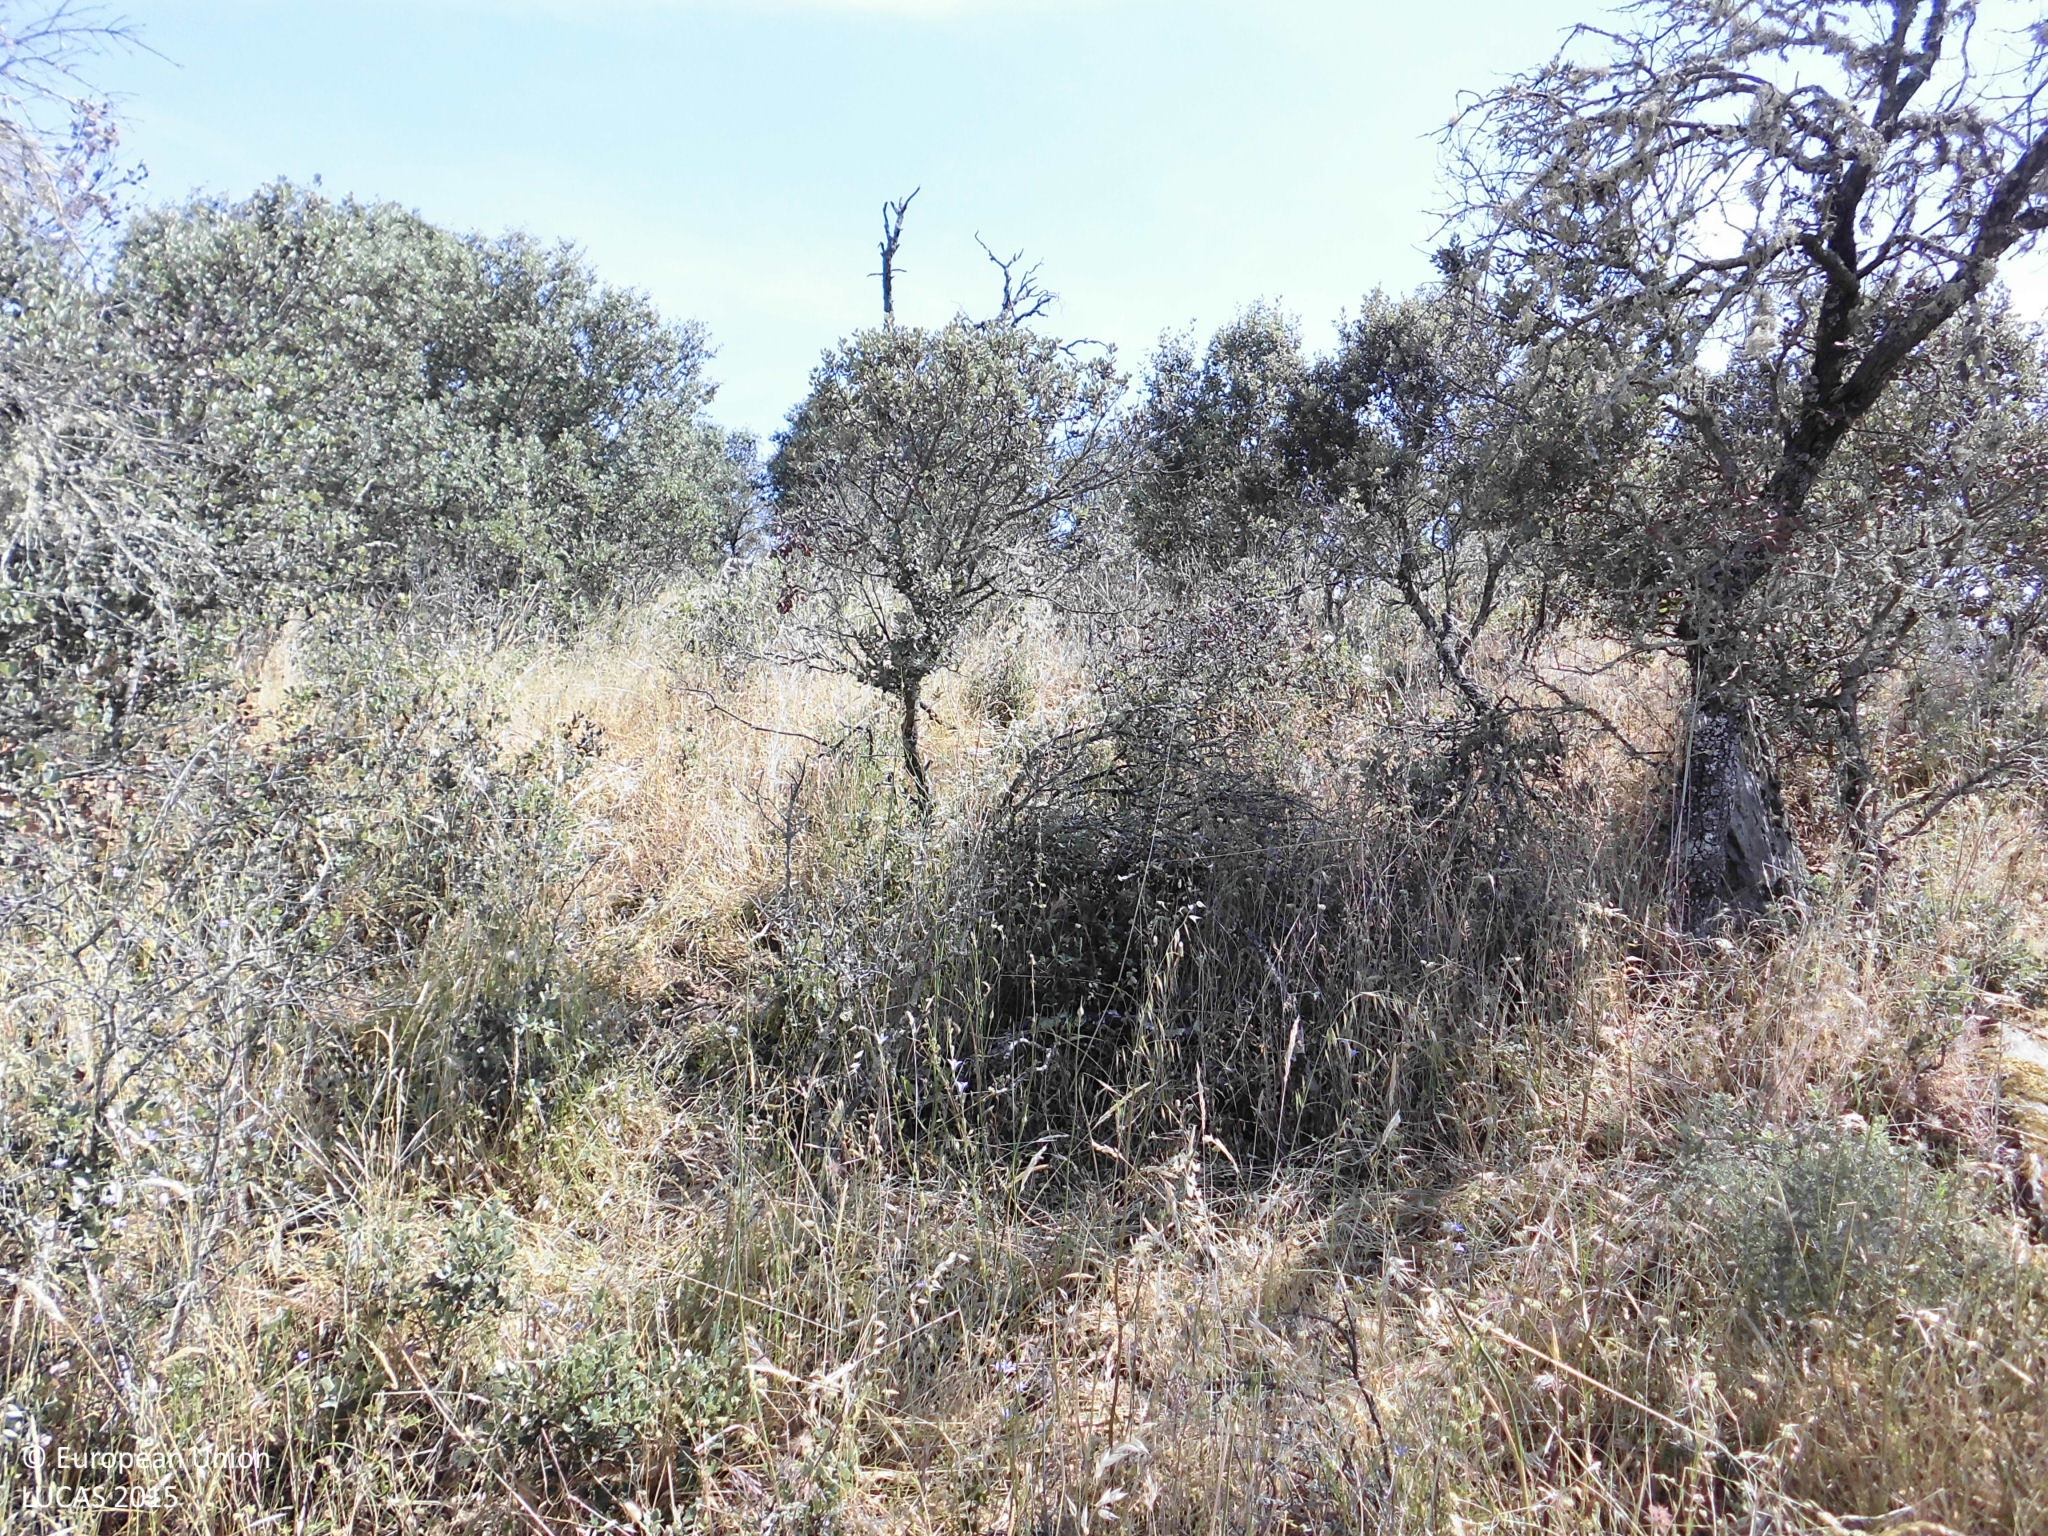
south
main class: Shrubland
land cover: Shrubland with sparse tree cover
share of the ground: 25 - 50 %
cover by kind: shrubs 40 %, herbaceous plants 30 %, unconsolidated bare surface 25 %, broadleaved forest trees 5 %
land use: Forestry
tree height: < 5 m
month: May
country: ES
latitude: 39.4532
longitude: -6.0402
